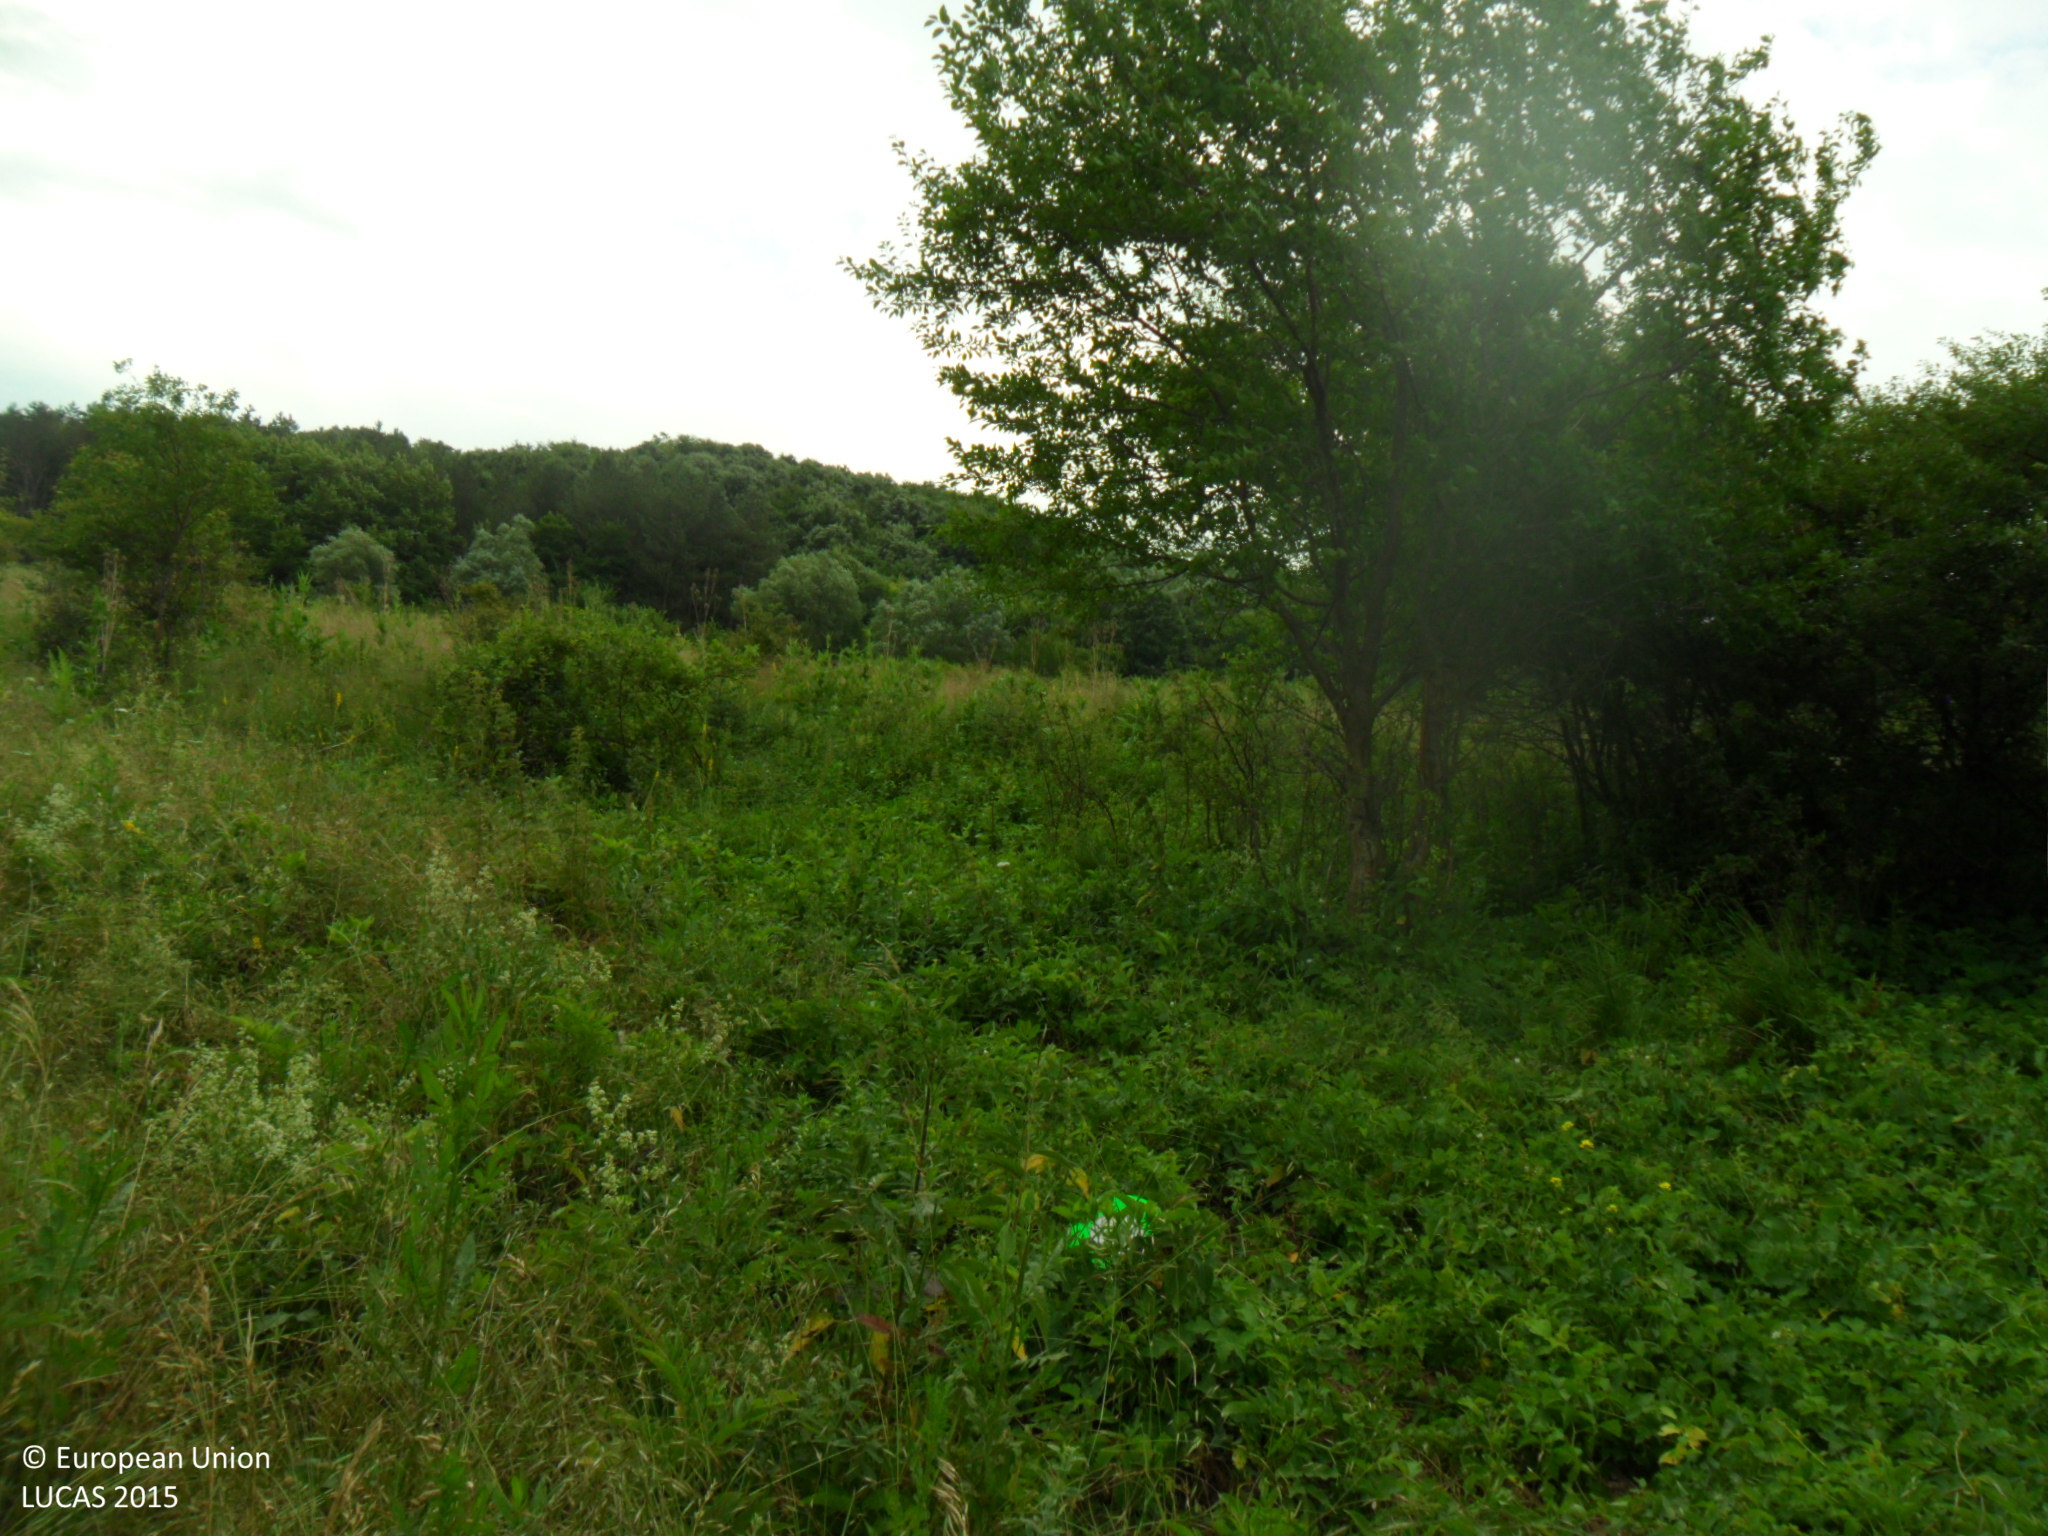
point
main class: Shrubland
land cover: Shrubland with sparse tree cover
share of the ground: > 75 %
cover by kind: herbaceous plants 60 %, shrubs 35 %, broadleaved forest trees 5 %
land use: Agriculture (excluding fallow land and kitchen gardens)
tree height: < 5 m
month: June
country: BG
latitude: 43.1645
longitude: 26.9501
